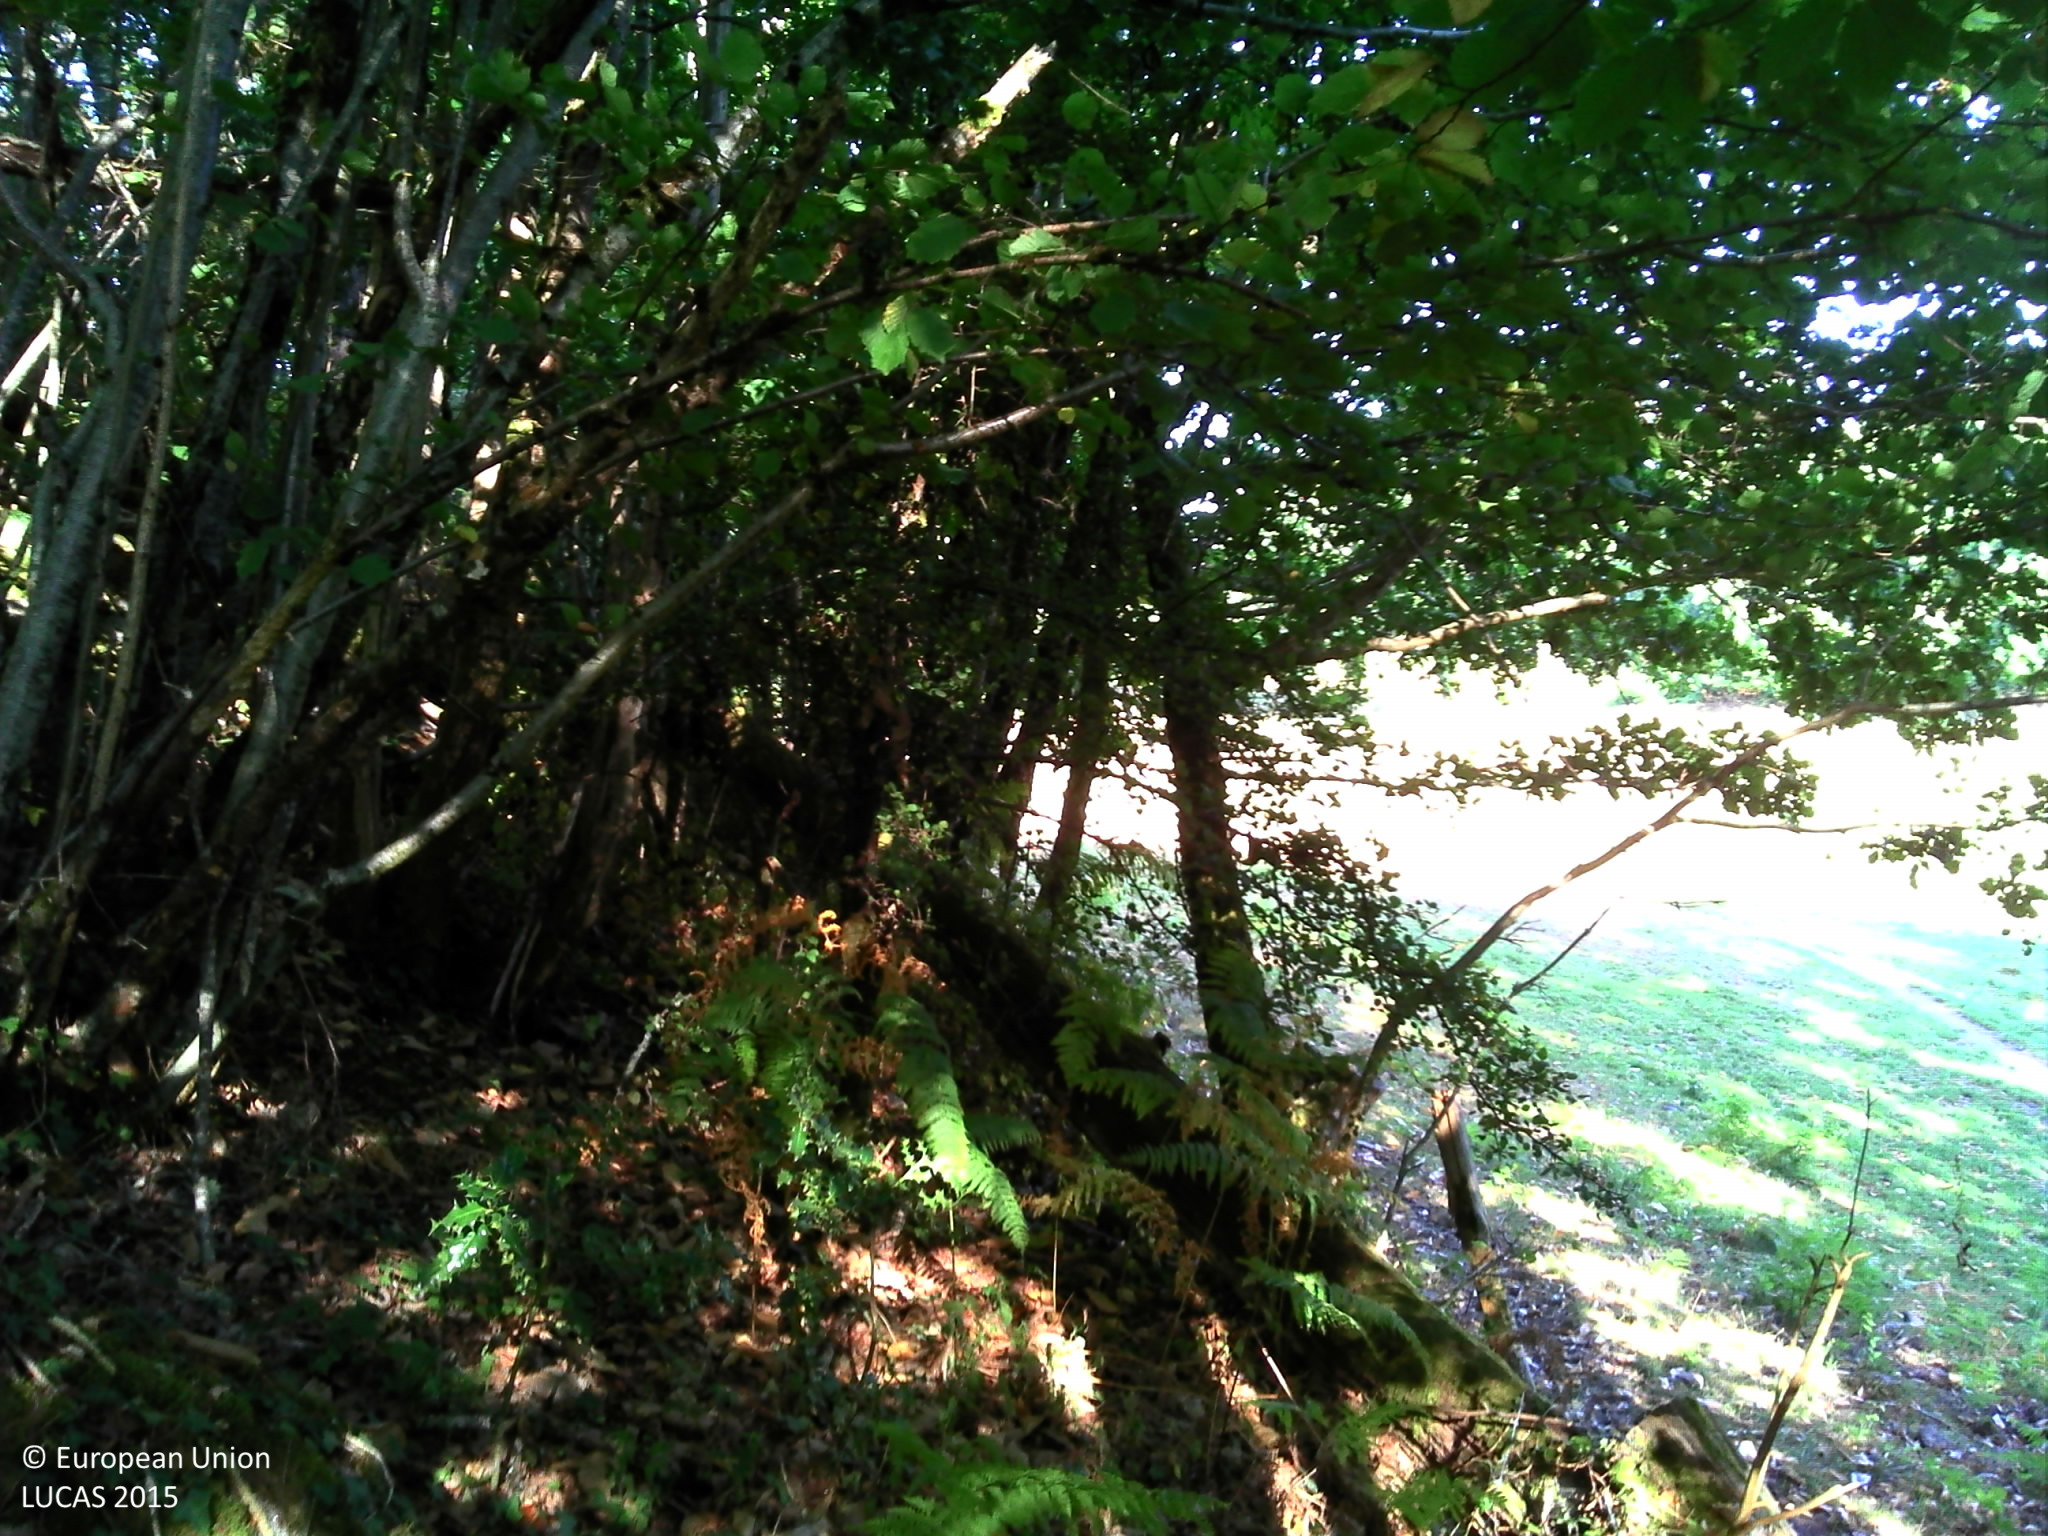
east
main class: Woodland
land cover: Broadleaved woodland
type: acidophilous oak and oak-birch forest
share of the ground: < 10 %
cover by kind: broadleaved forest trees 45 %, herbaceous plants 30 %, lichens and mosses 20 %
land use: Forestry
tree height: > 5 m
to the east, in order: Broadleaved woodland; Fences; Grassland without tree/shrub cover; Fences; Broadleaved woodland
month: July
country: FR
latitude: 45.8298
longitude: 1.0426
